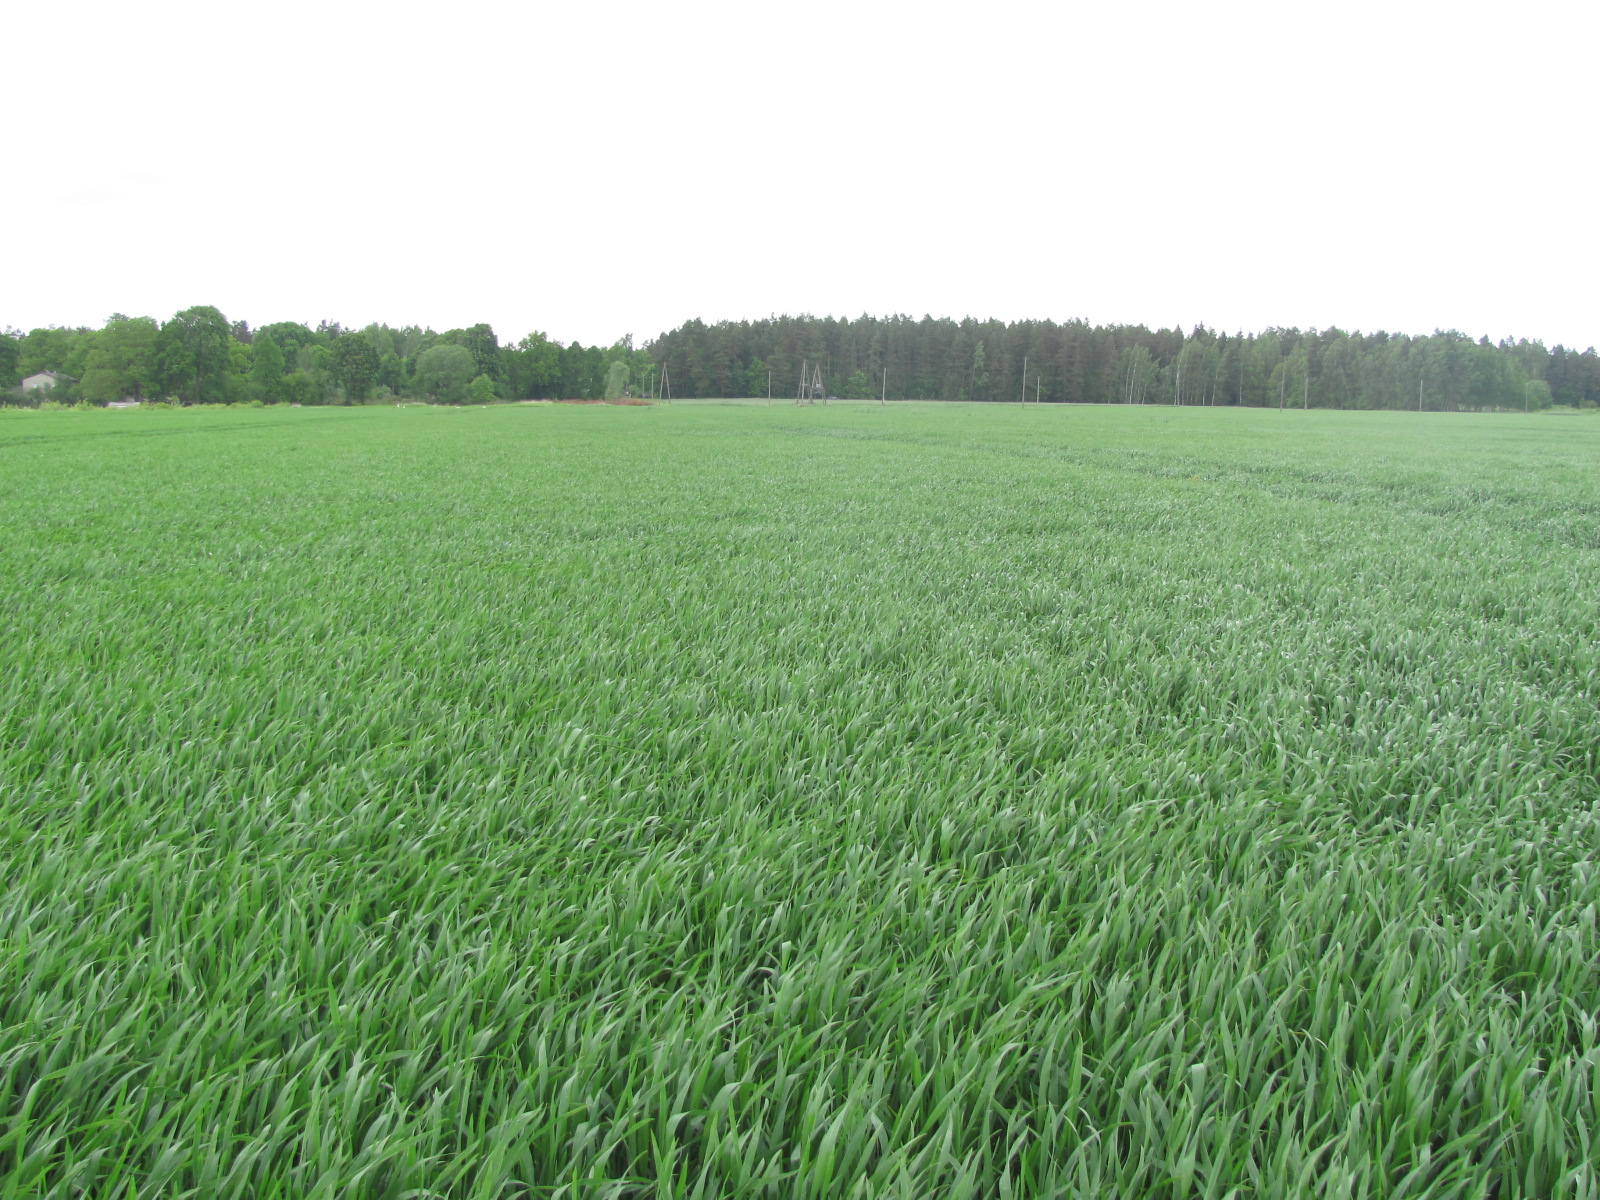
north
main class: Cropland
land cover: Common wheat
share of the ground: > 75 %
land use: Agriculture (excluding fallow land and kitchen gardens)
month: June
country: LV
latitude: 56.7849
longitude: 24.0136
